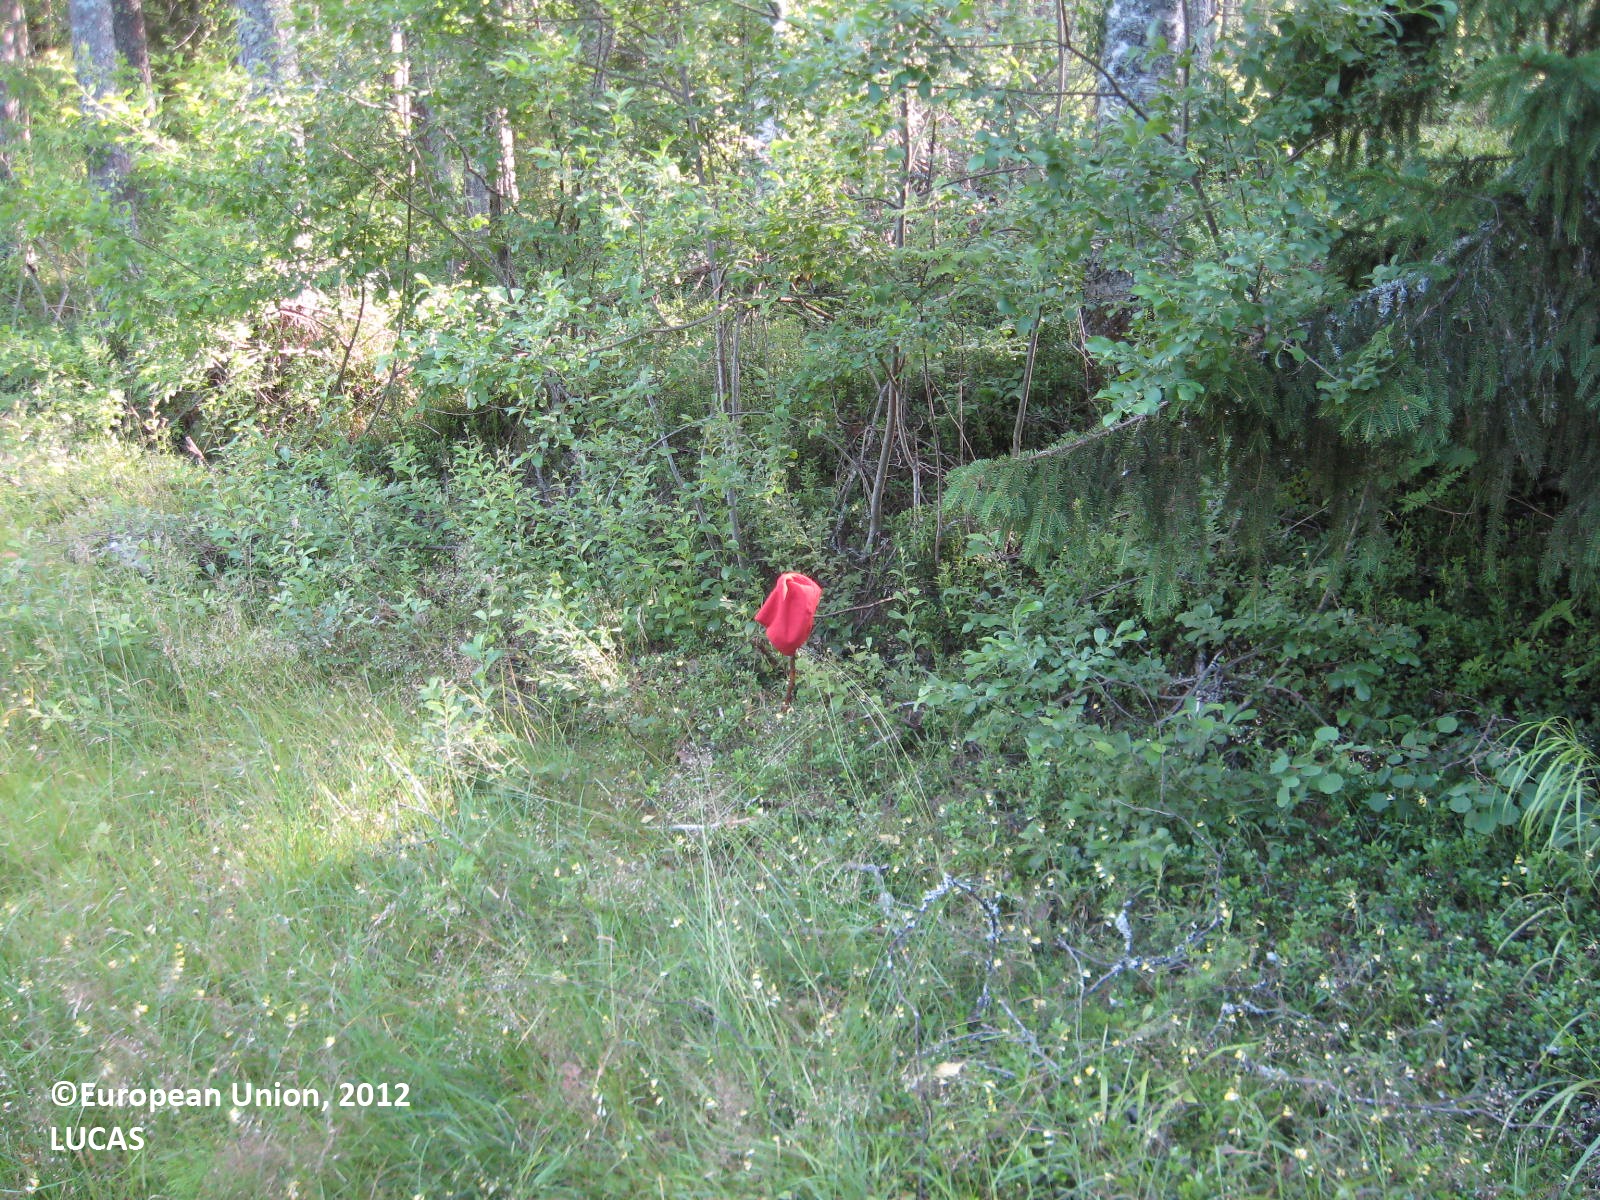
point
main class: Grassland
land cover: Grassland without tree/shrub cover
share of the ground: > 75 %
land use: Fallow land
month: July
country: FI
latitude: 62.0337
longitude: 21.6125
